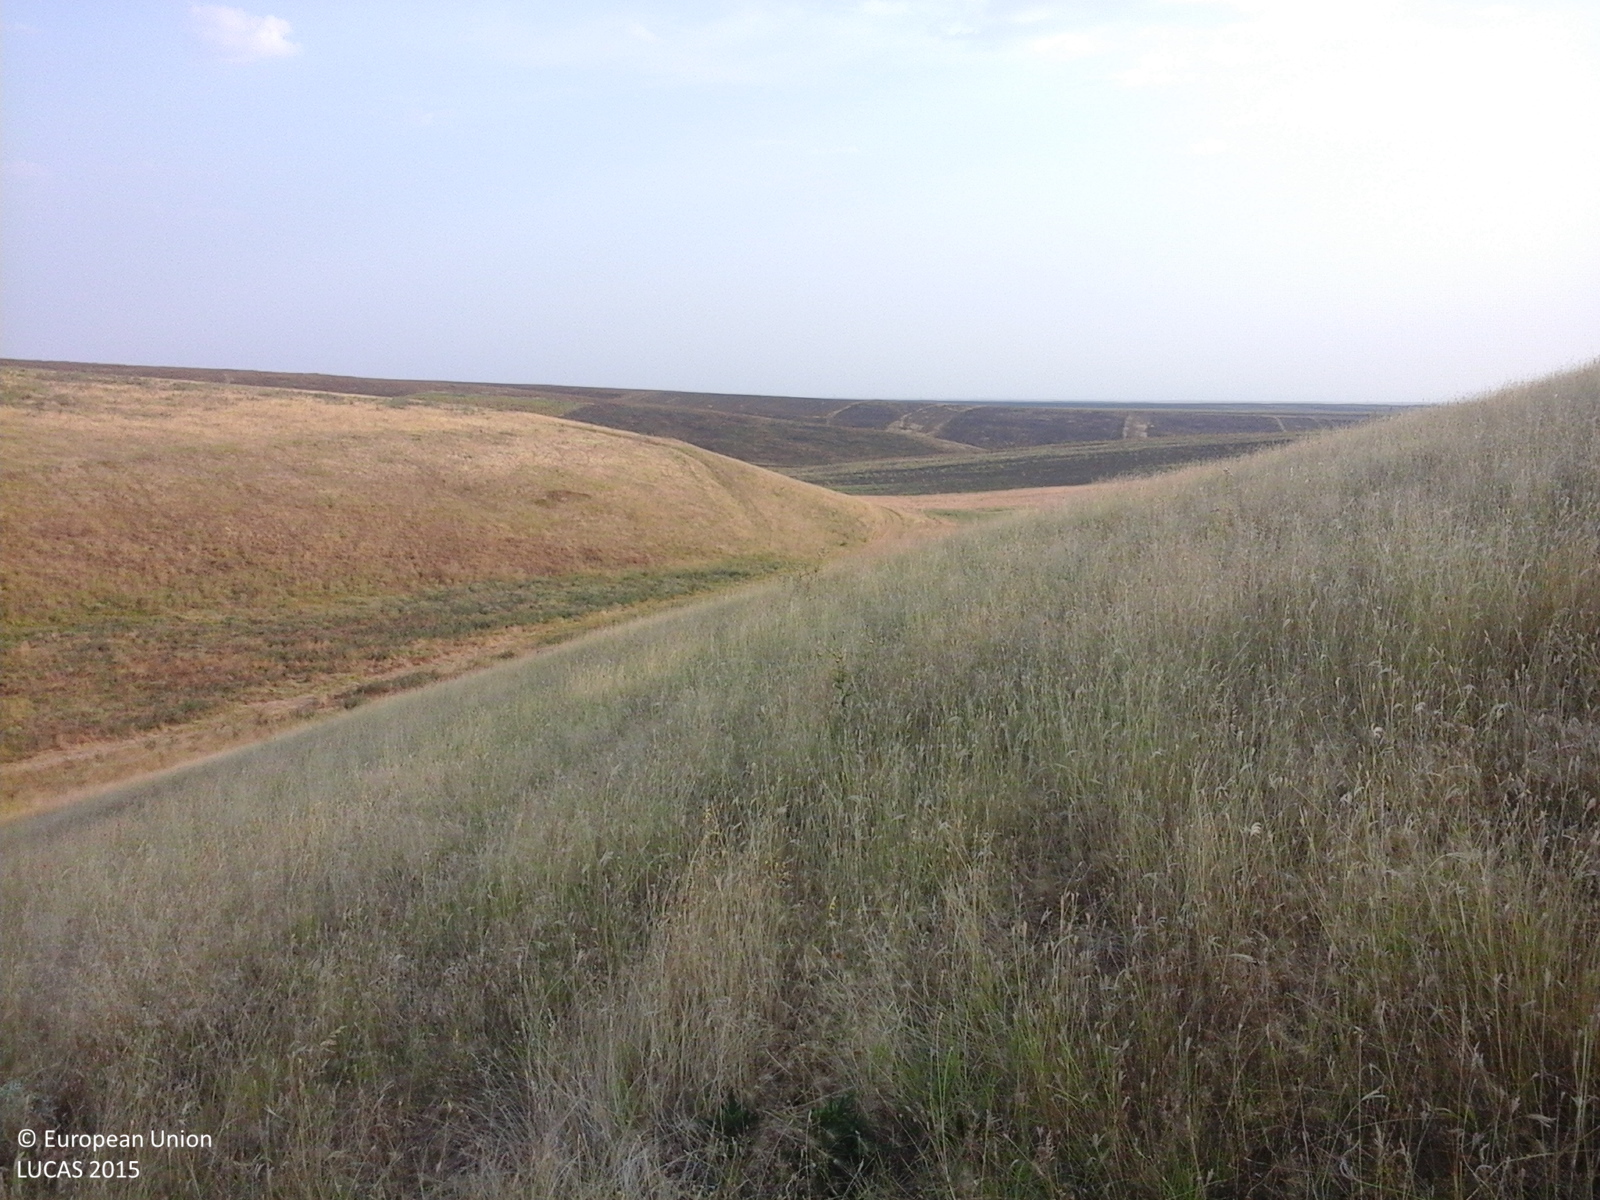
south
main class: Grassland
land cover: Grassland without tree/shrub cover
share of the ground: > 75 %
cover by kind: herbaceous plants 100 %
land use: Agriculture (excluding fallow land and kitchen gardens)
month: August
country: RO
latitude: 44.2662
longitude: 23.0855
